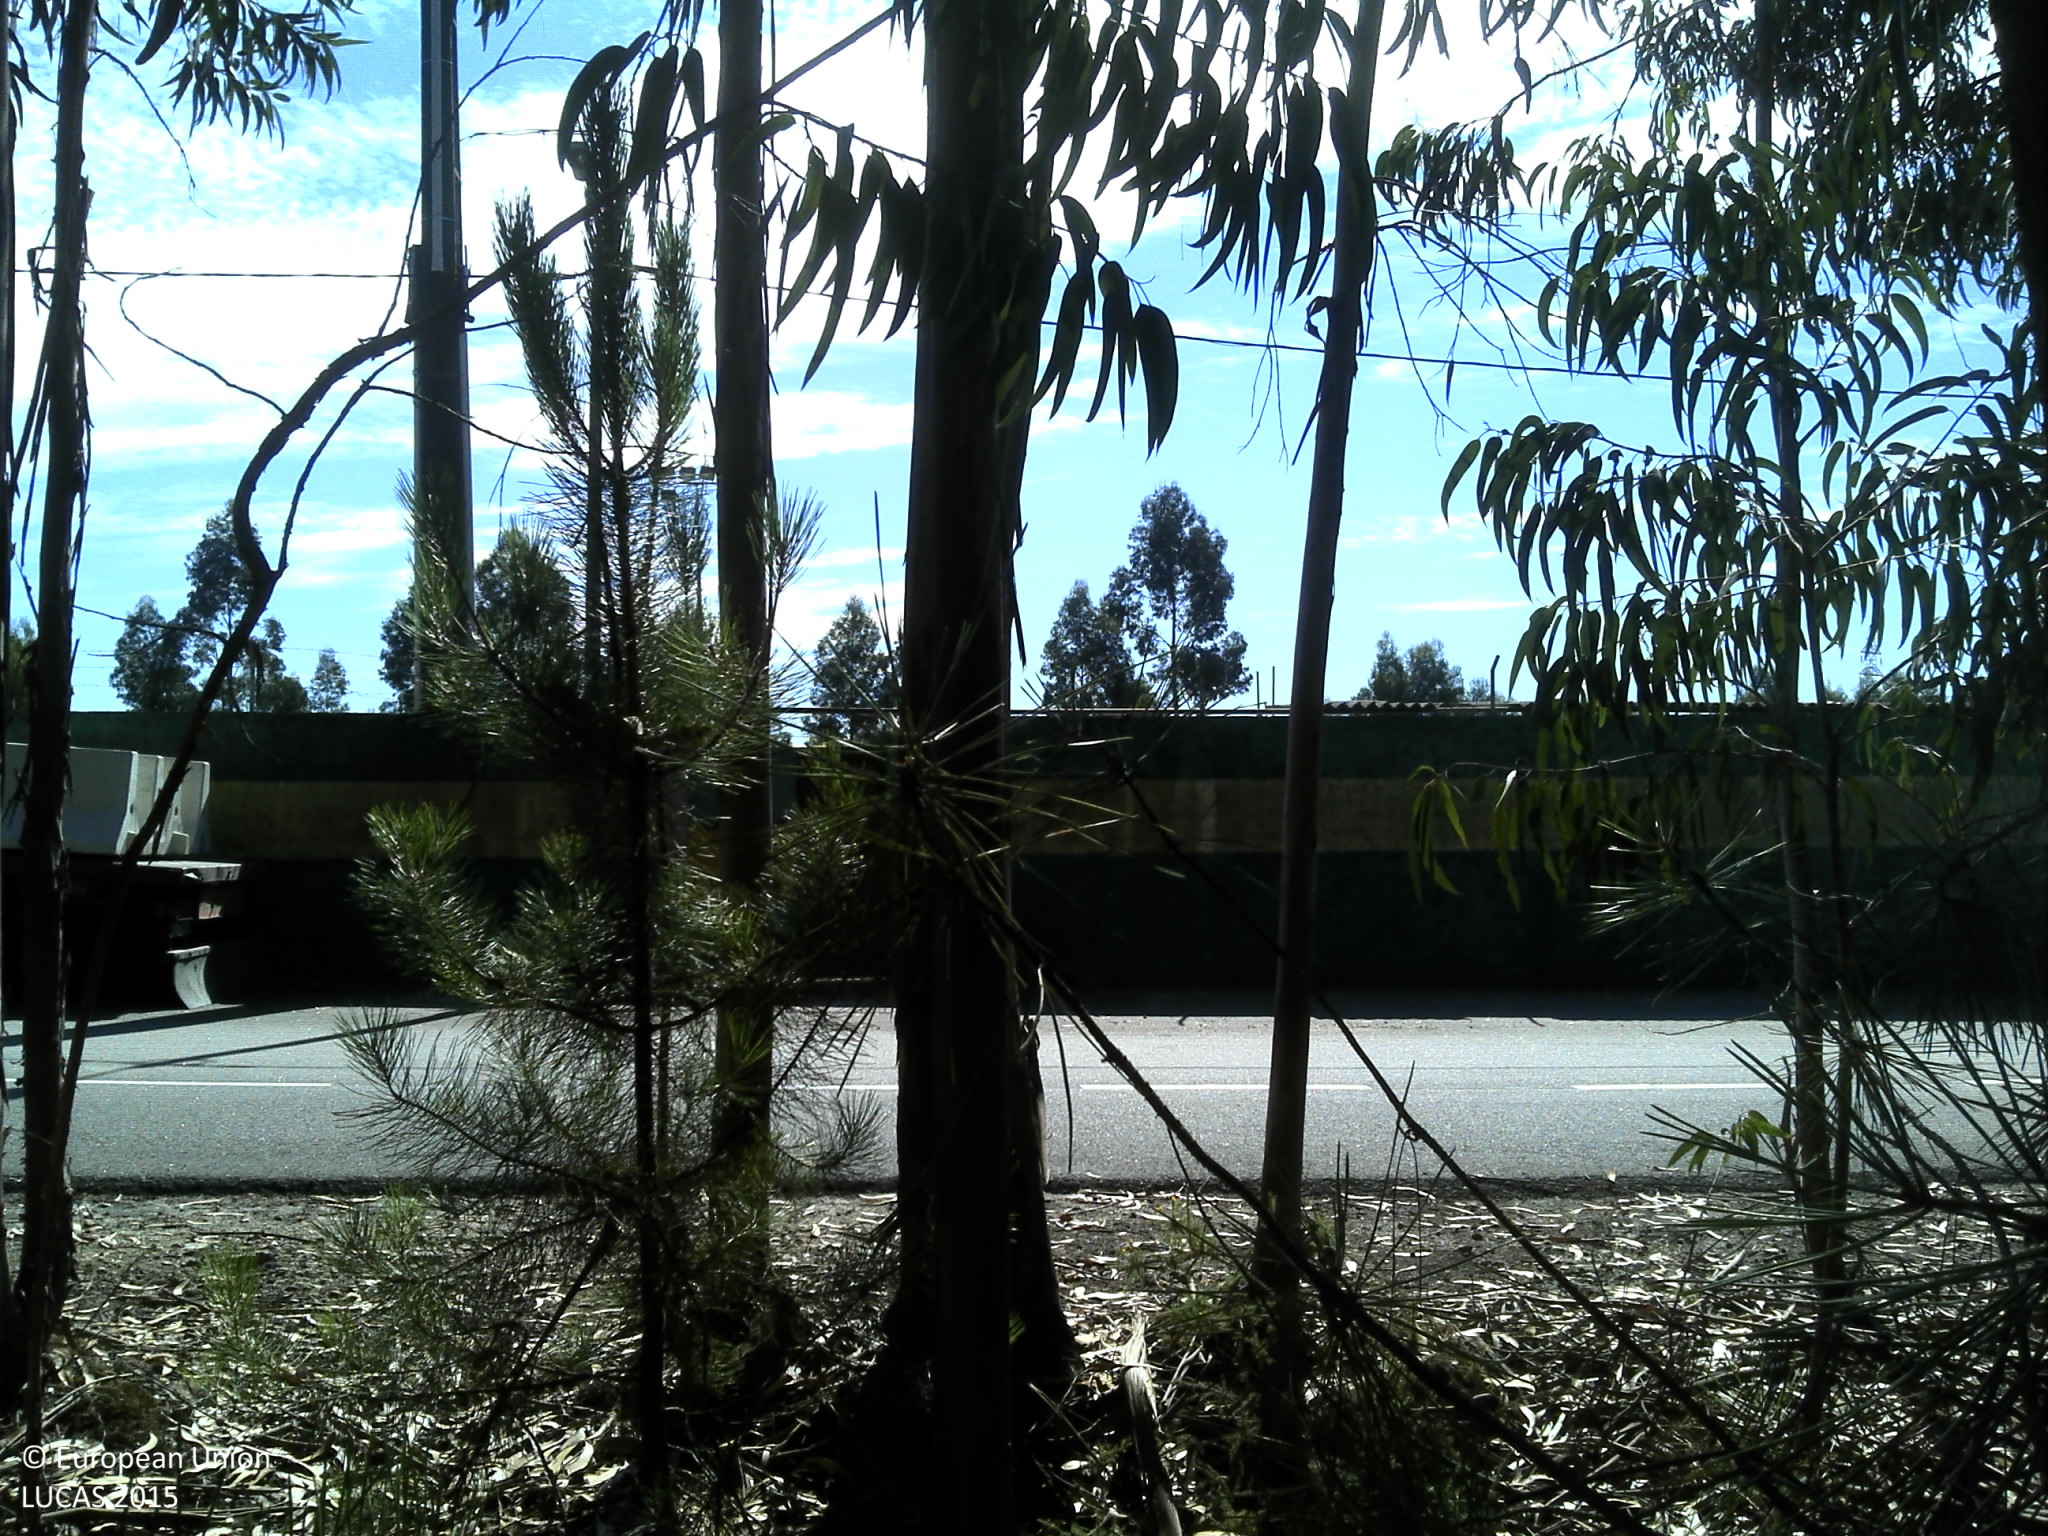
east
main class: Woodland
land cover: Broadleaved woodland
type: exotic forest
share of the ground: 50 - 75 %
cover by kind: broadleaved forest trees 70 %, unconsolidated bare surface 20 %, coniferous forest trees 5 %, shrubs 5 %
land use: Forestry
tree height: > 5 m
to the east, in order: Broadleaved woodland; Artificial constructions in urban areas; Broadleaved woodland; Tracks; Broadleaved woodland
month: July
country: PT
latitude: 41.0424
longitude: -8.4053
